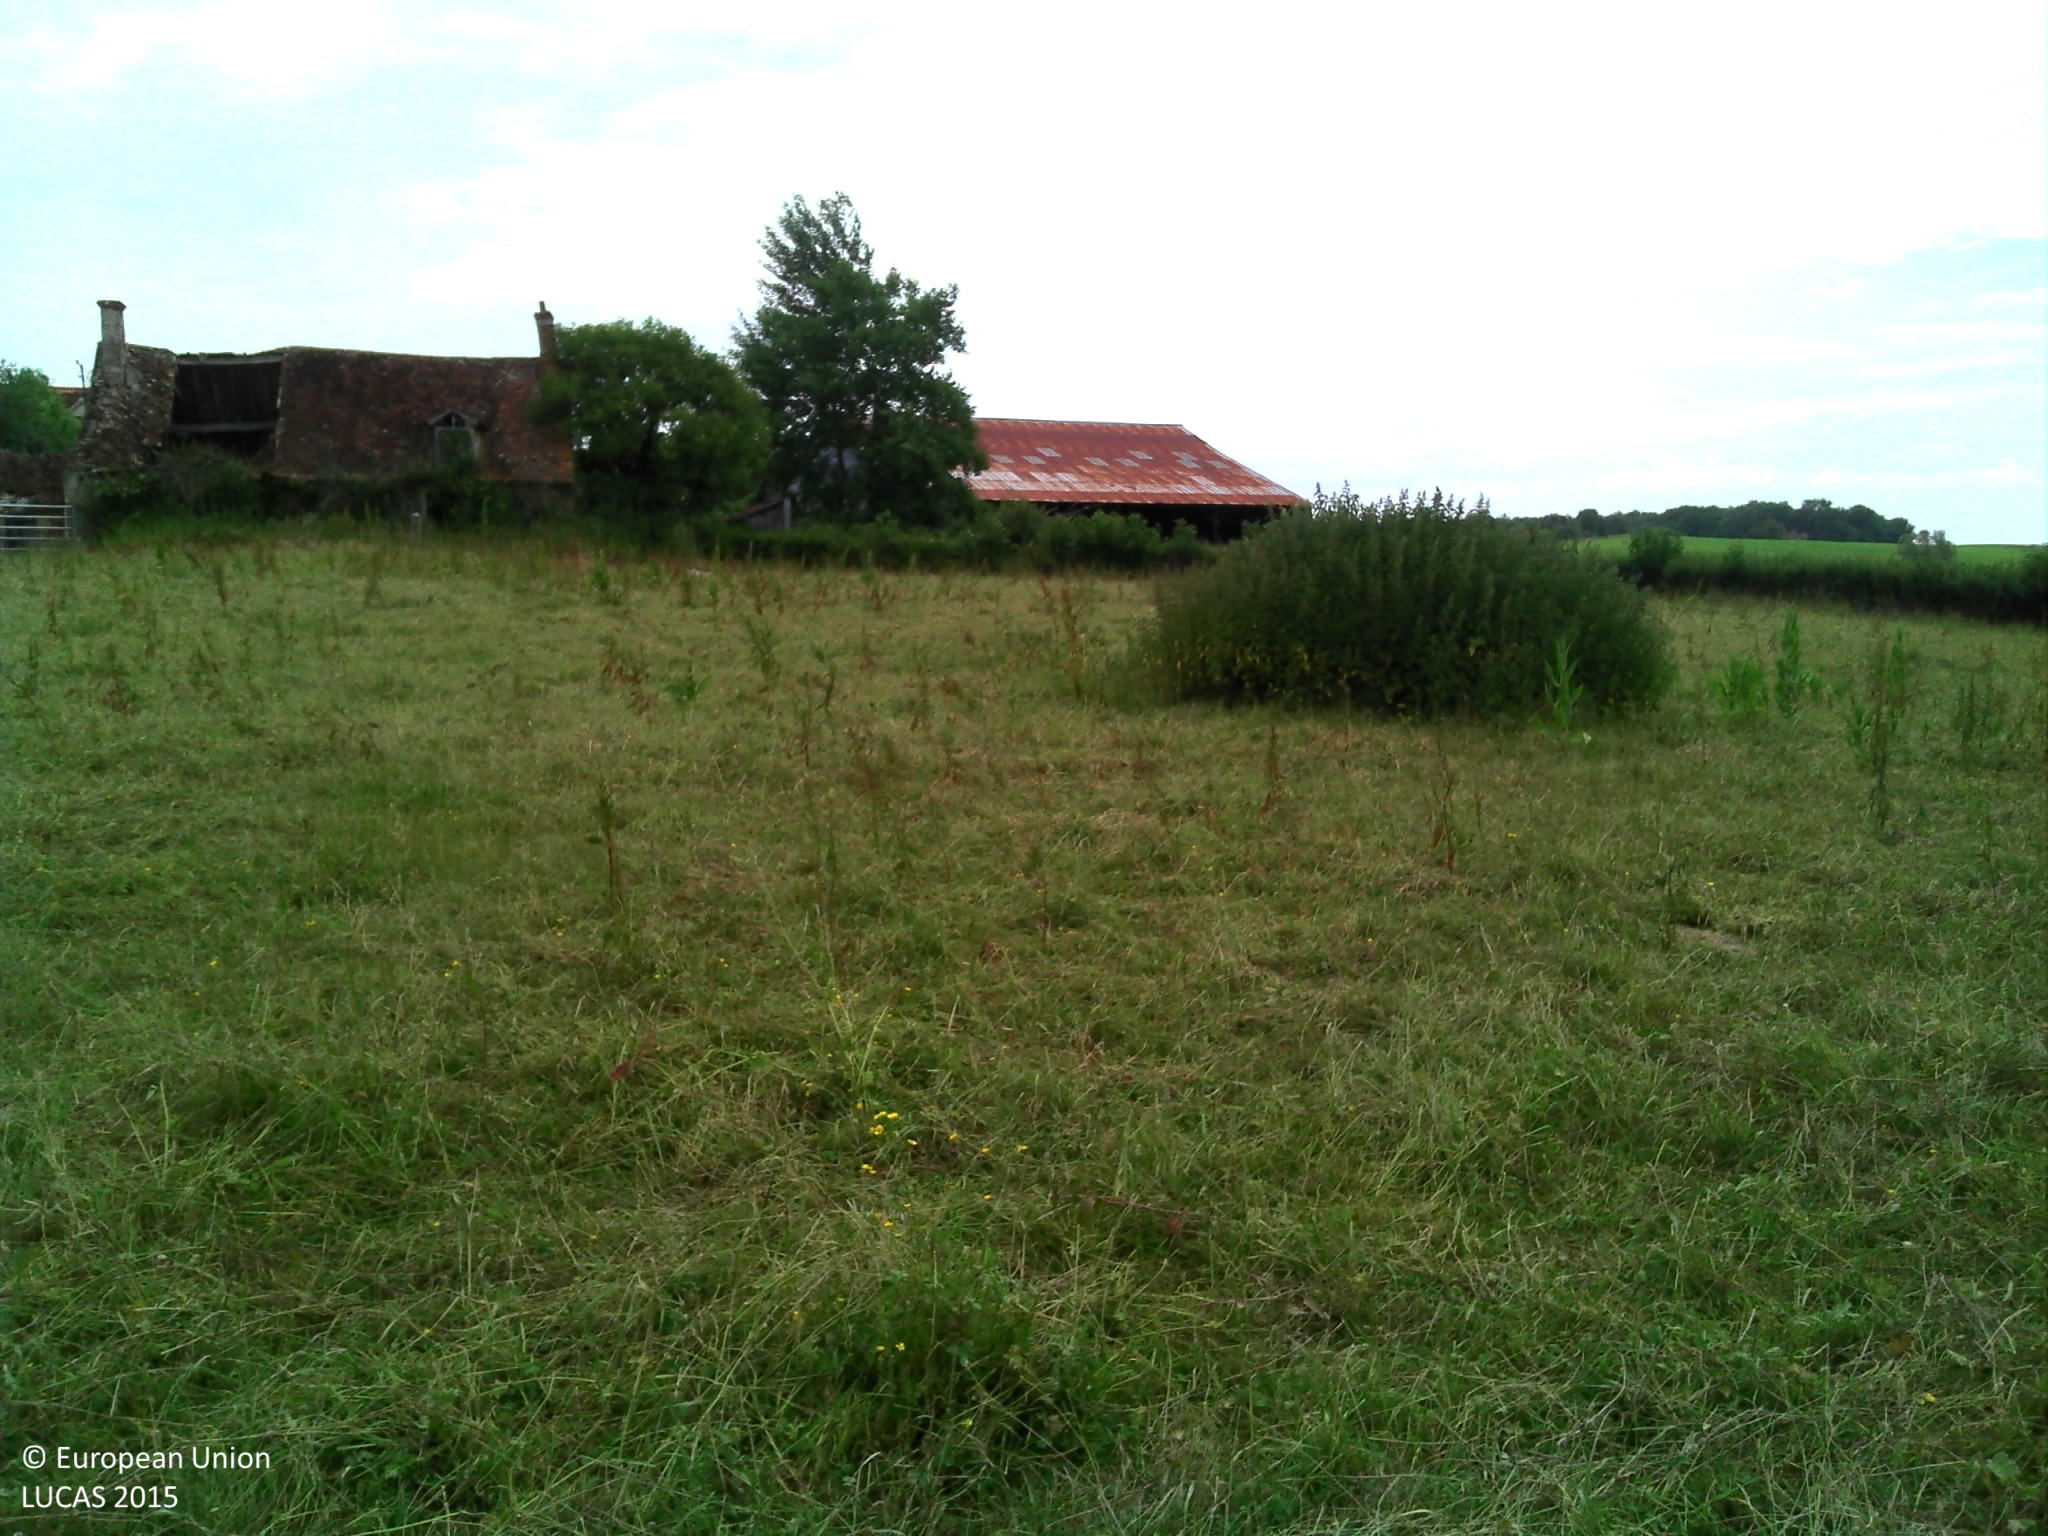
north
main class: Grassland
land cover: Grassland without tree/shrub cover
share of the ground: > 75 %
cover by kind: herbaceous plants 100 %
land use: Agriculture (excluding fallow land and kitchen gardens)
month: June
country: FR
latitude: 46.7689
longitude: 2.6750
